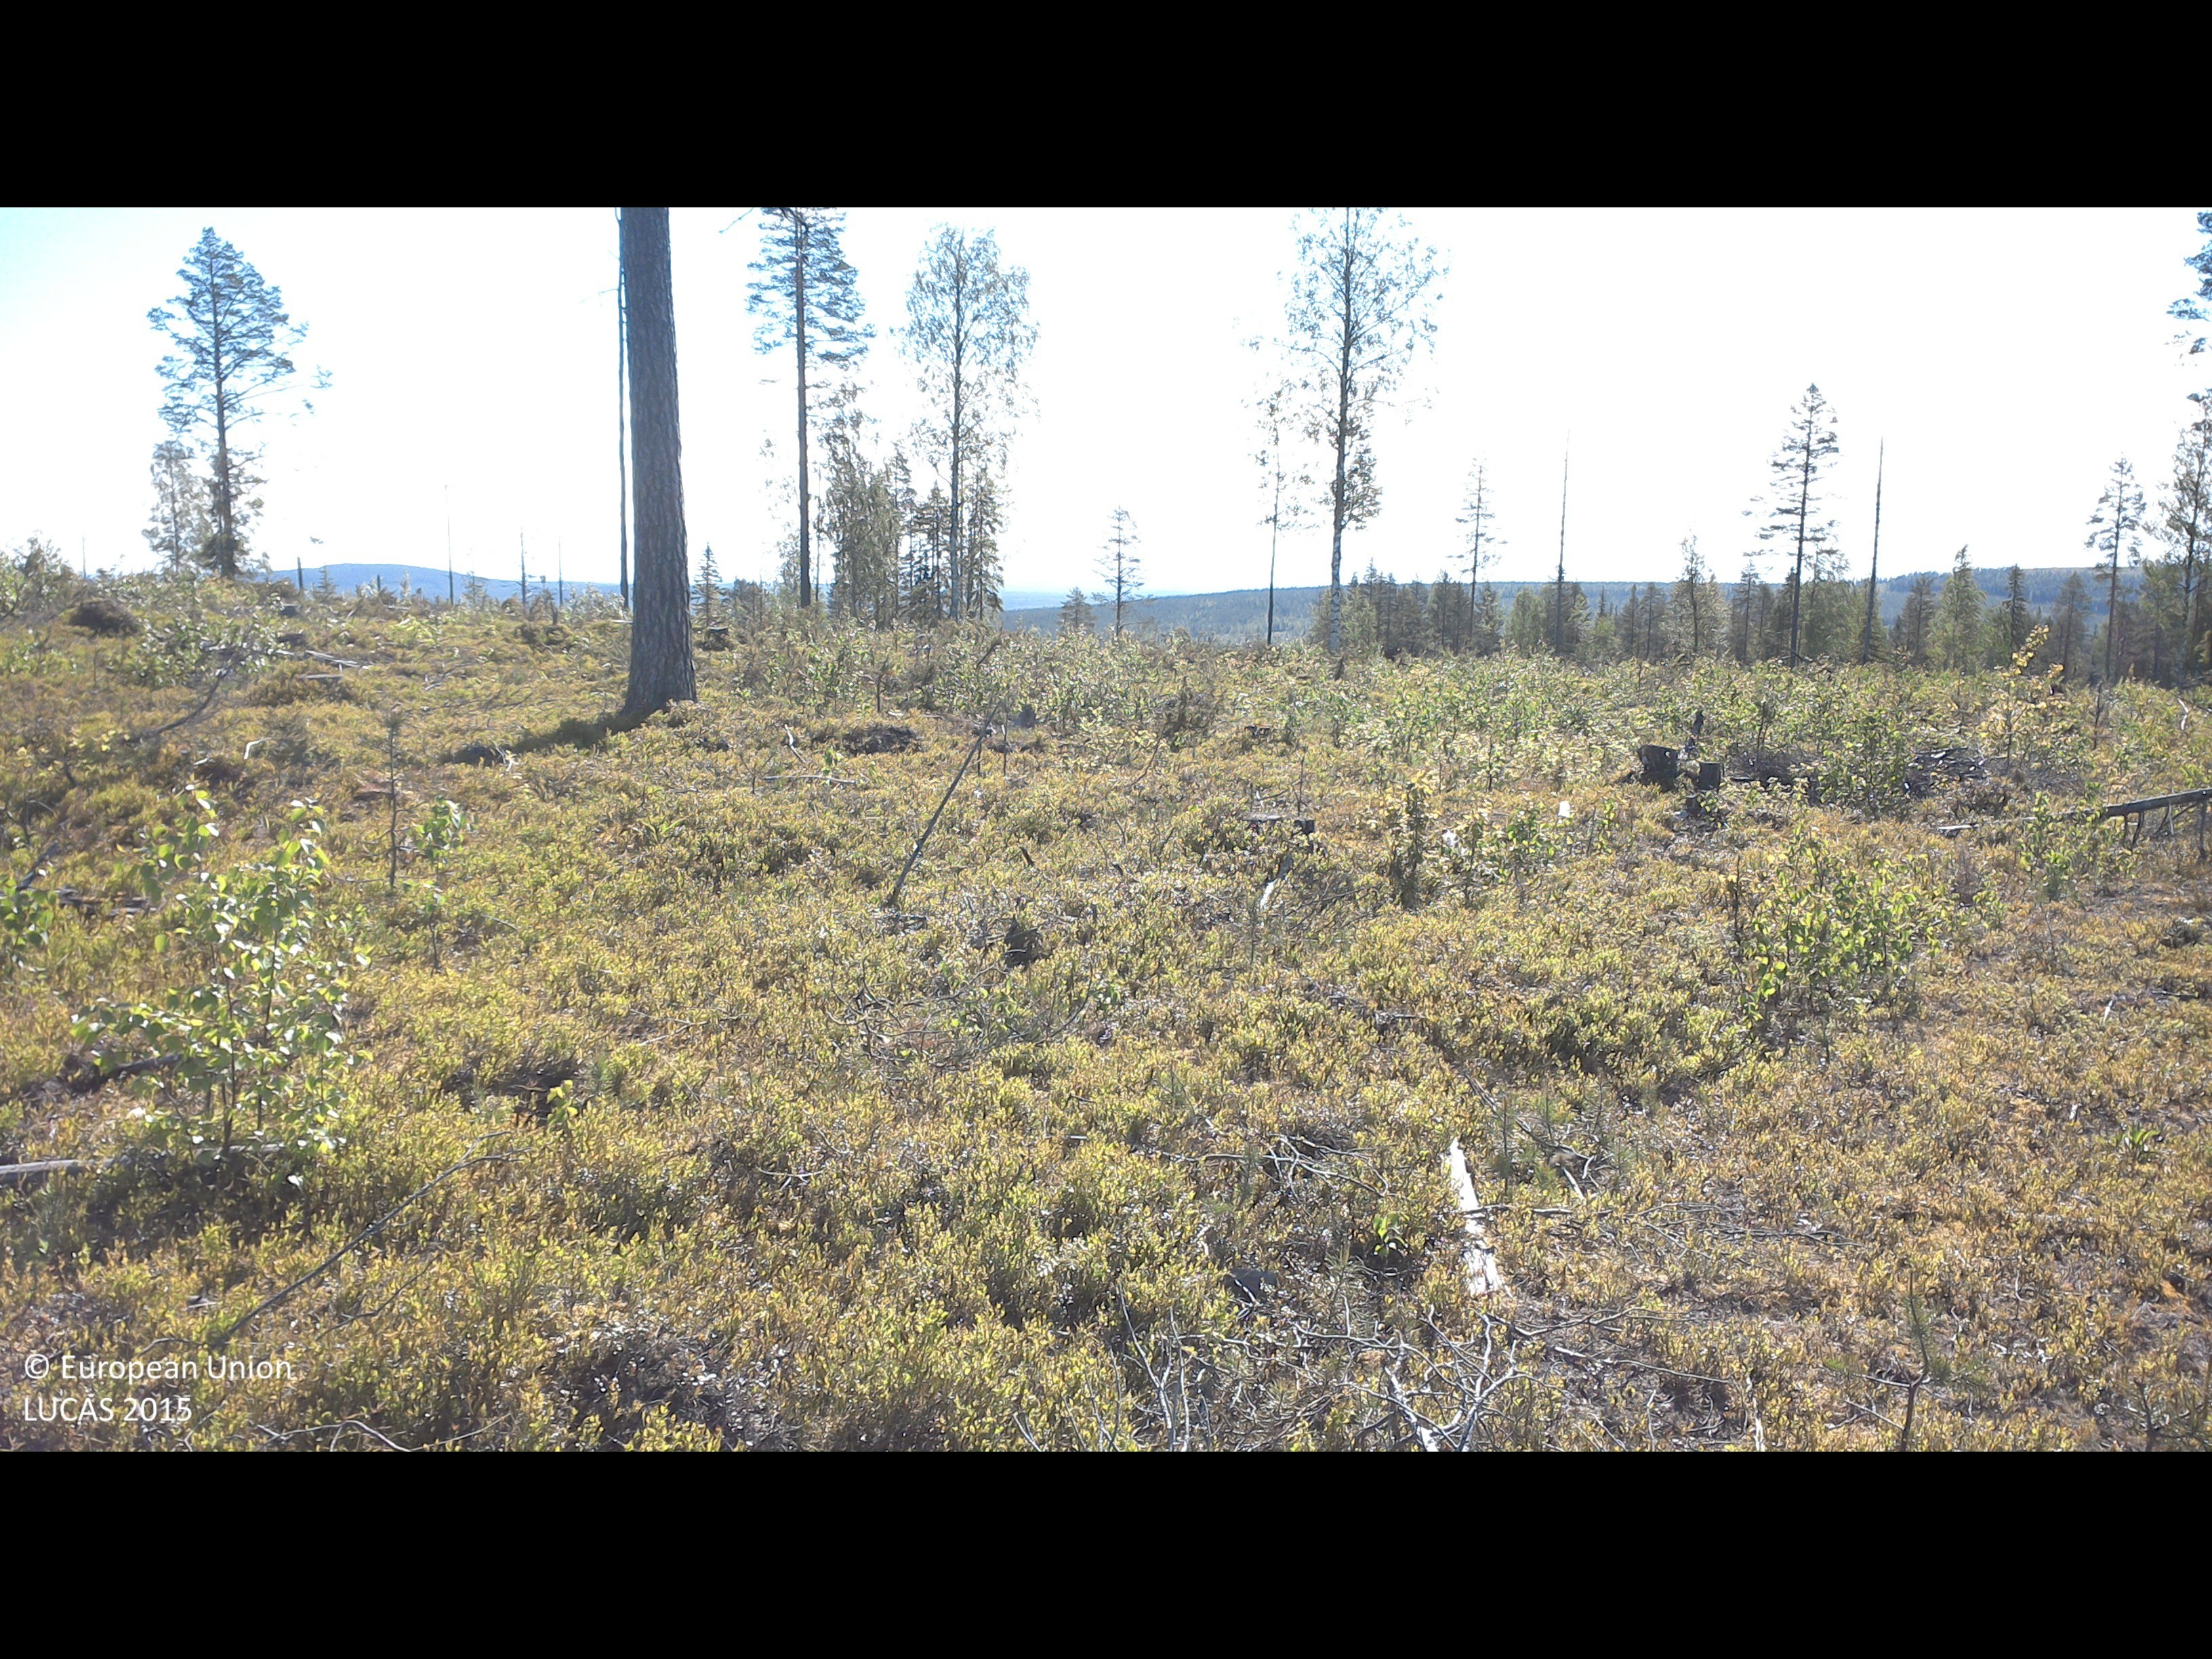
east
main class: Woodland
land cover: Broadleaved woodland
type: boreal forest
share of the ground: 10 - 25 %
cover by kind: shrubs 85 %, broadleaved forest trees 10 %, lichens and mosses 5 %
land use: Forestry
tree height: < 5 m
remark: Clear cut
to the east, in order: Broadleaved woodland; Other mixed woodland; Broadleaved woodland; Other mixed woodland; Broadleaved woodland; Other mixed woodland; Spruce dominated mixed woodland; Broadleaved woodland
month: June
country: SE
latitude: 66.6860
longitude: 22.5822
